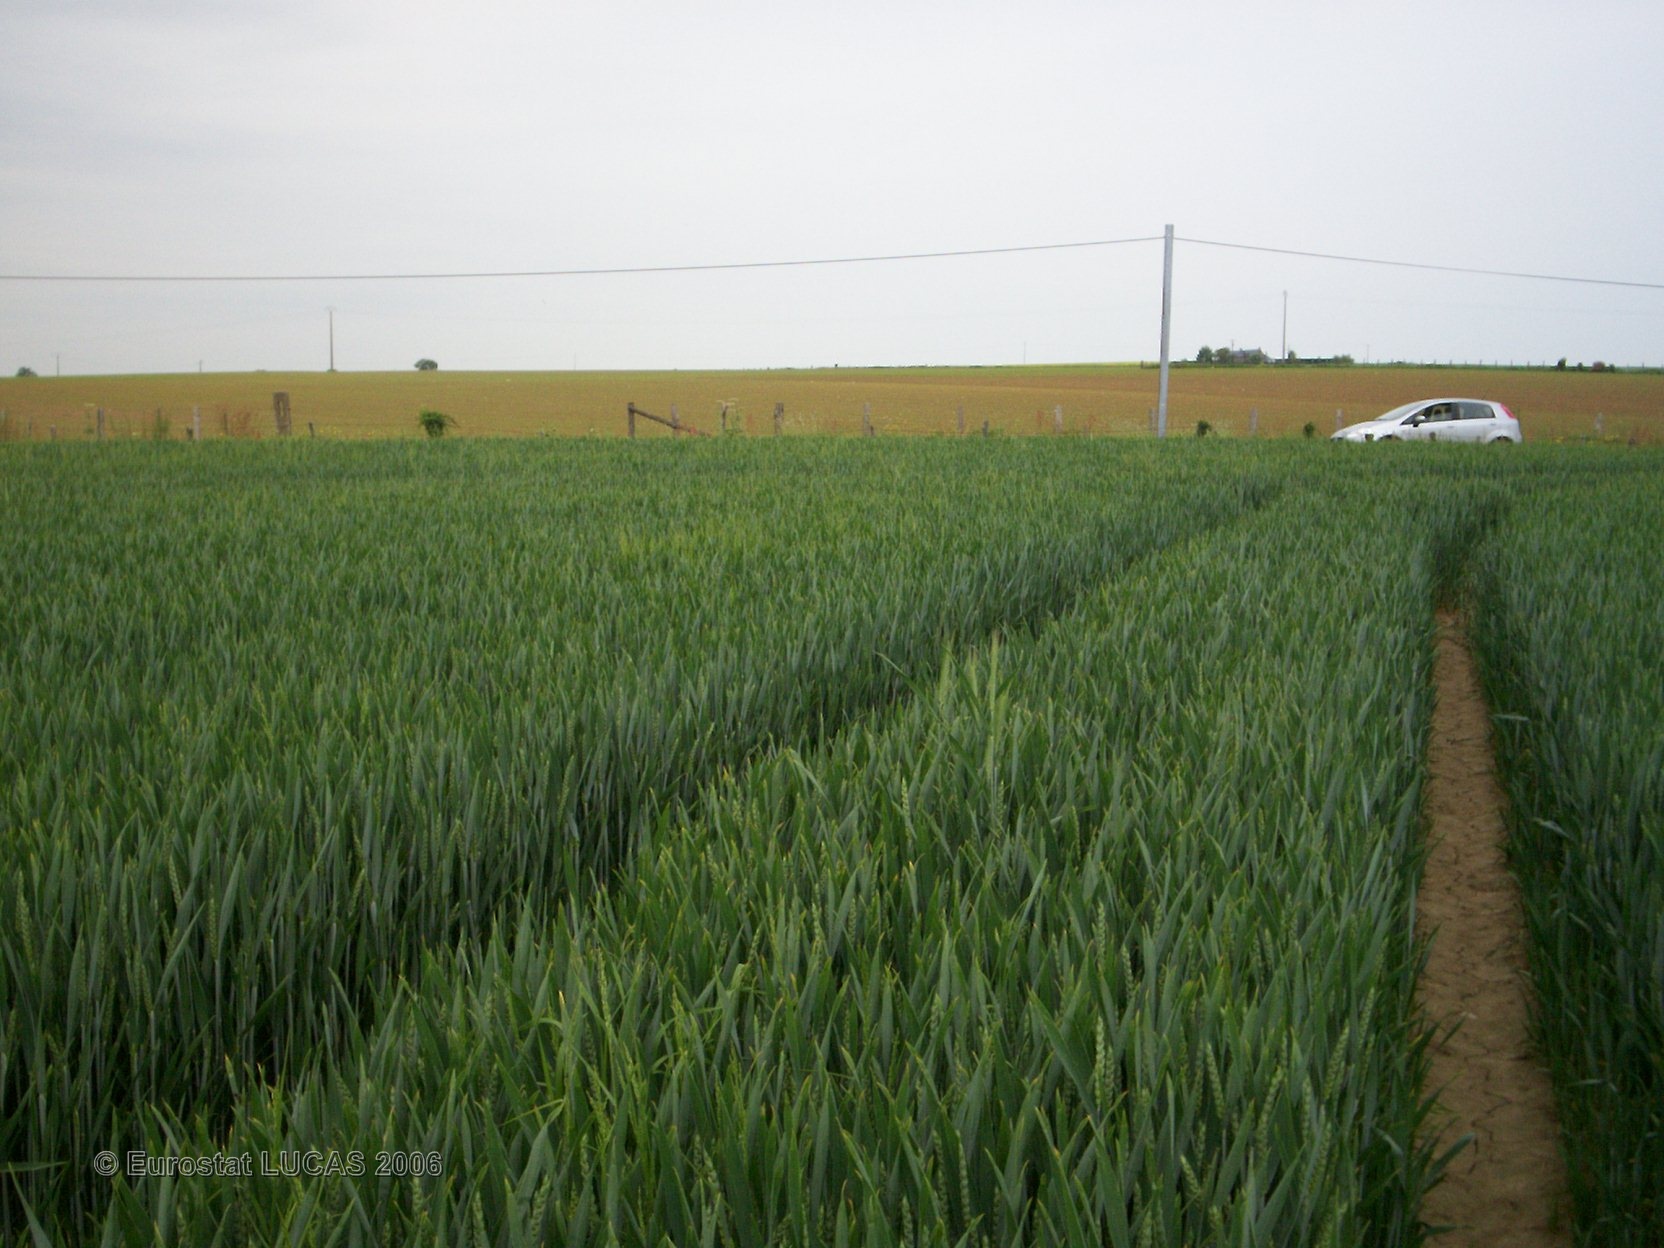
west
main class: Cropland
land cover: Common wheat
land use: Agriculture (excluding fallow land and kitchen gardens)
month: May
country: FR
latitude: 47.6279
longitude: -1.4203
